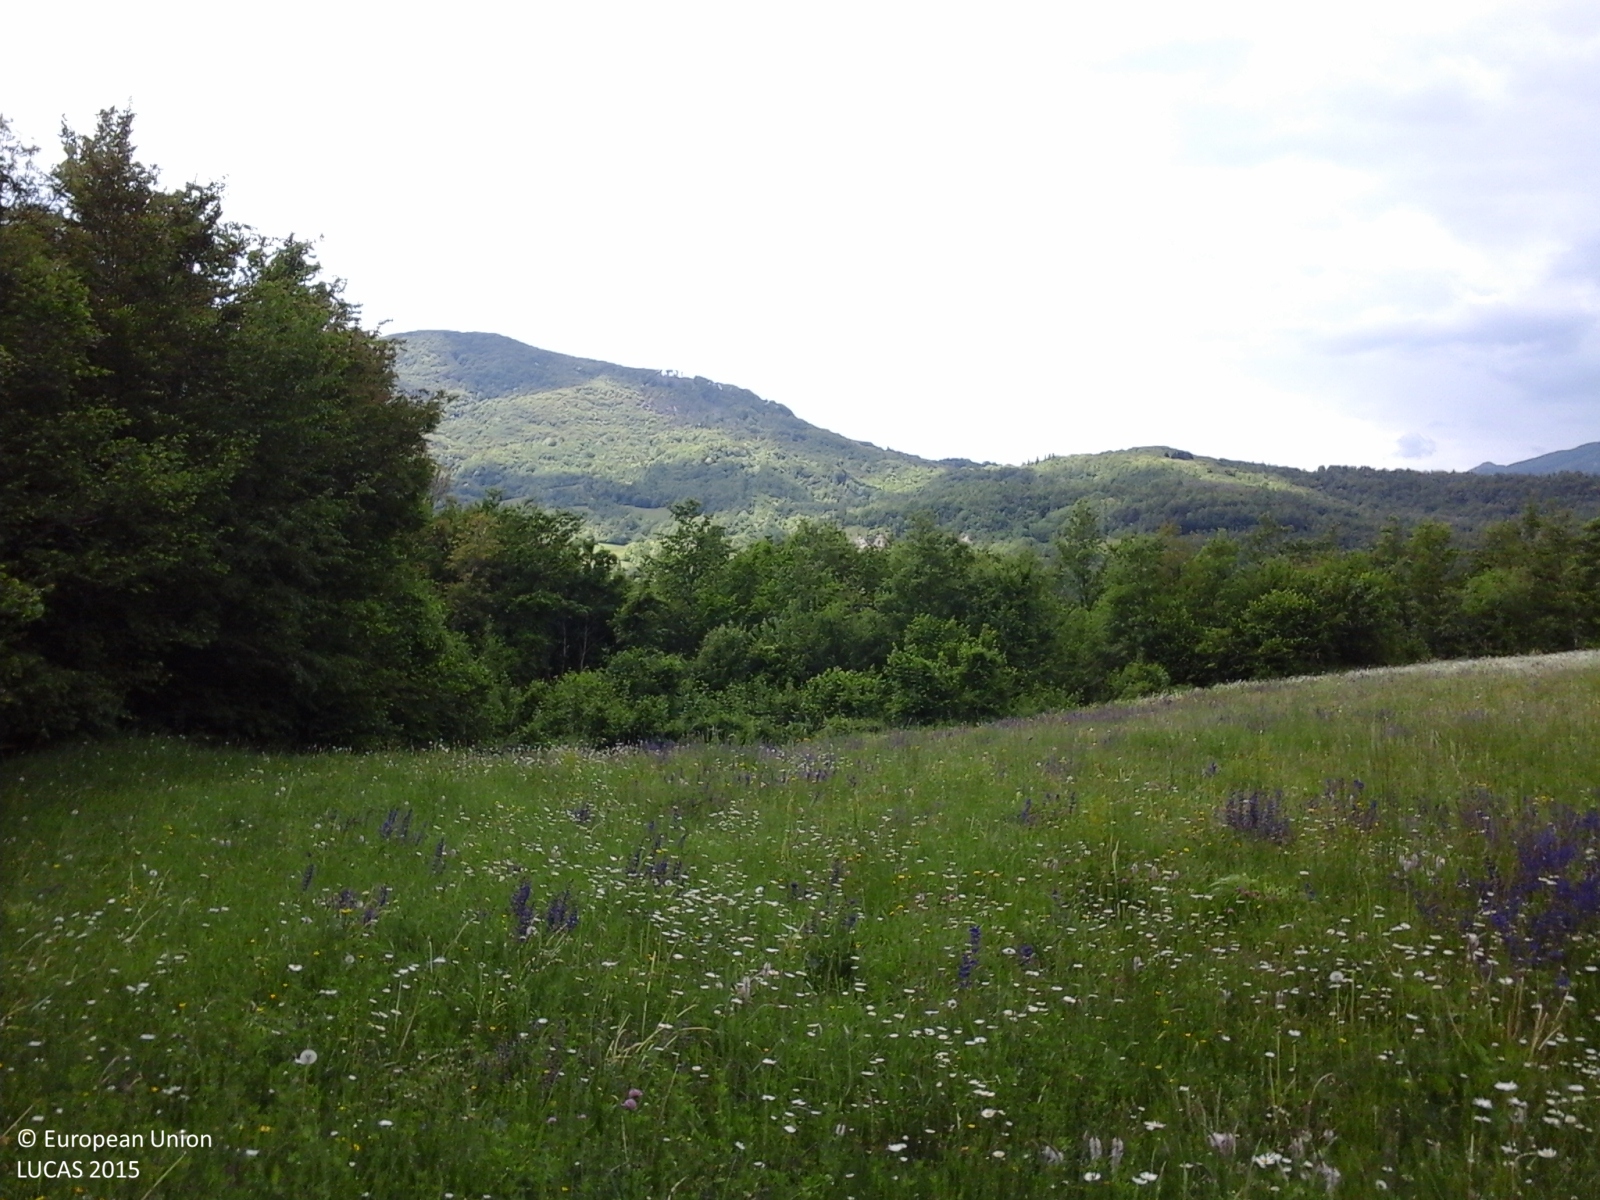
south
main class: Woodland
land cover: Broadleaved woodland
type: thermophilous deciduous forest
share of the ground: > 75 %
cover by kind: broadleaved forest trees 100 %
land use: Forestry
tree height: > 5 m
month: May
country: IT
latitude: 44.4587
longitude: 10.1129
